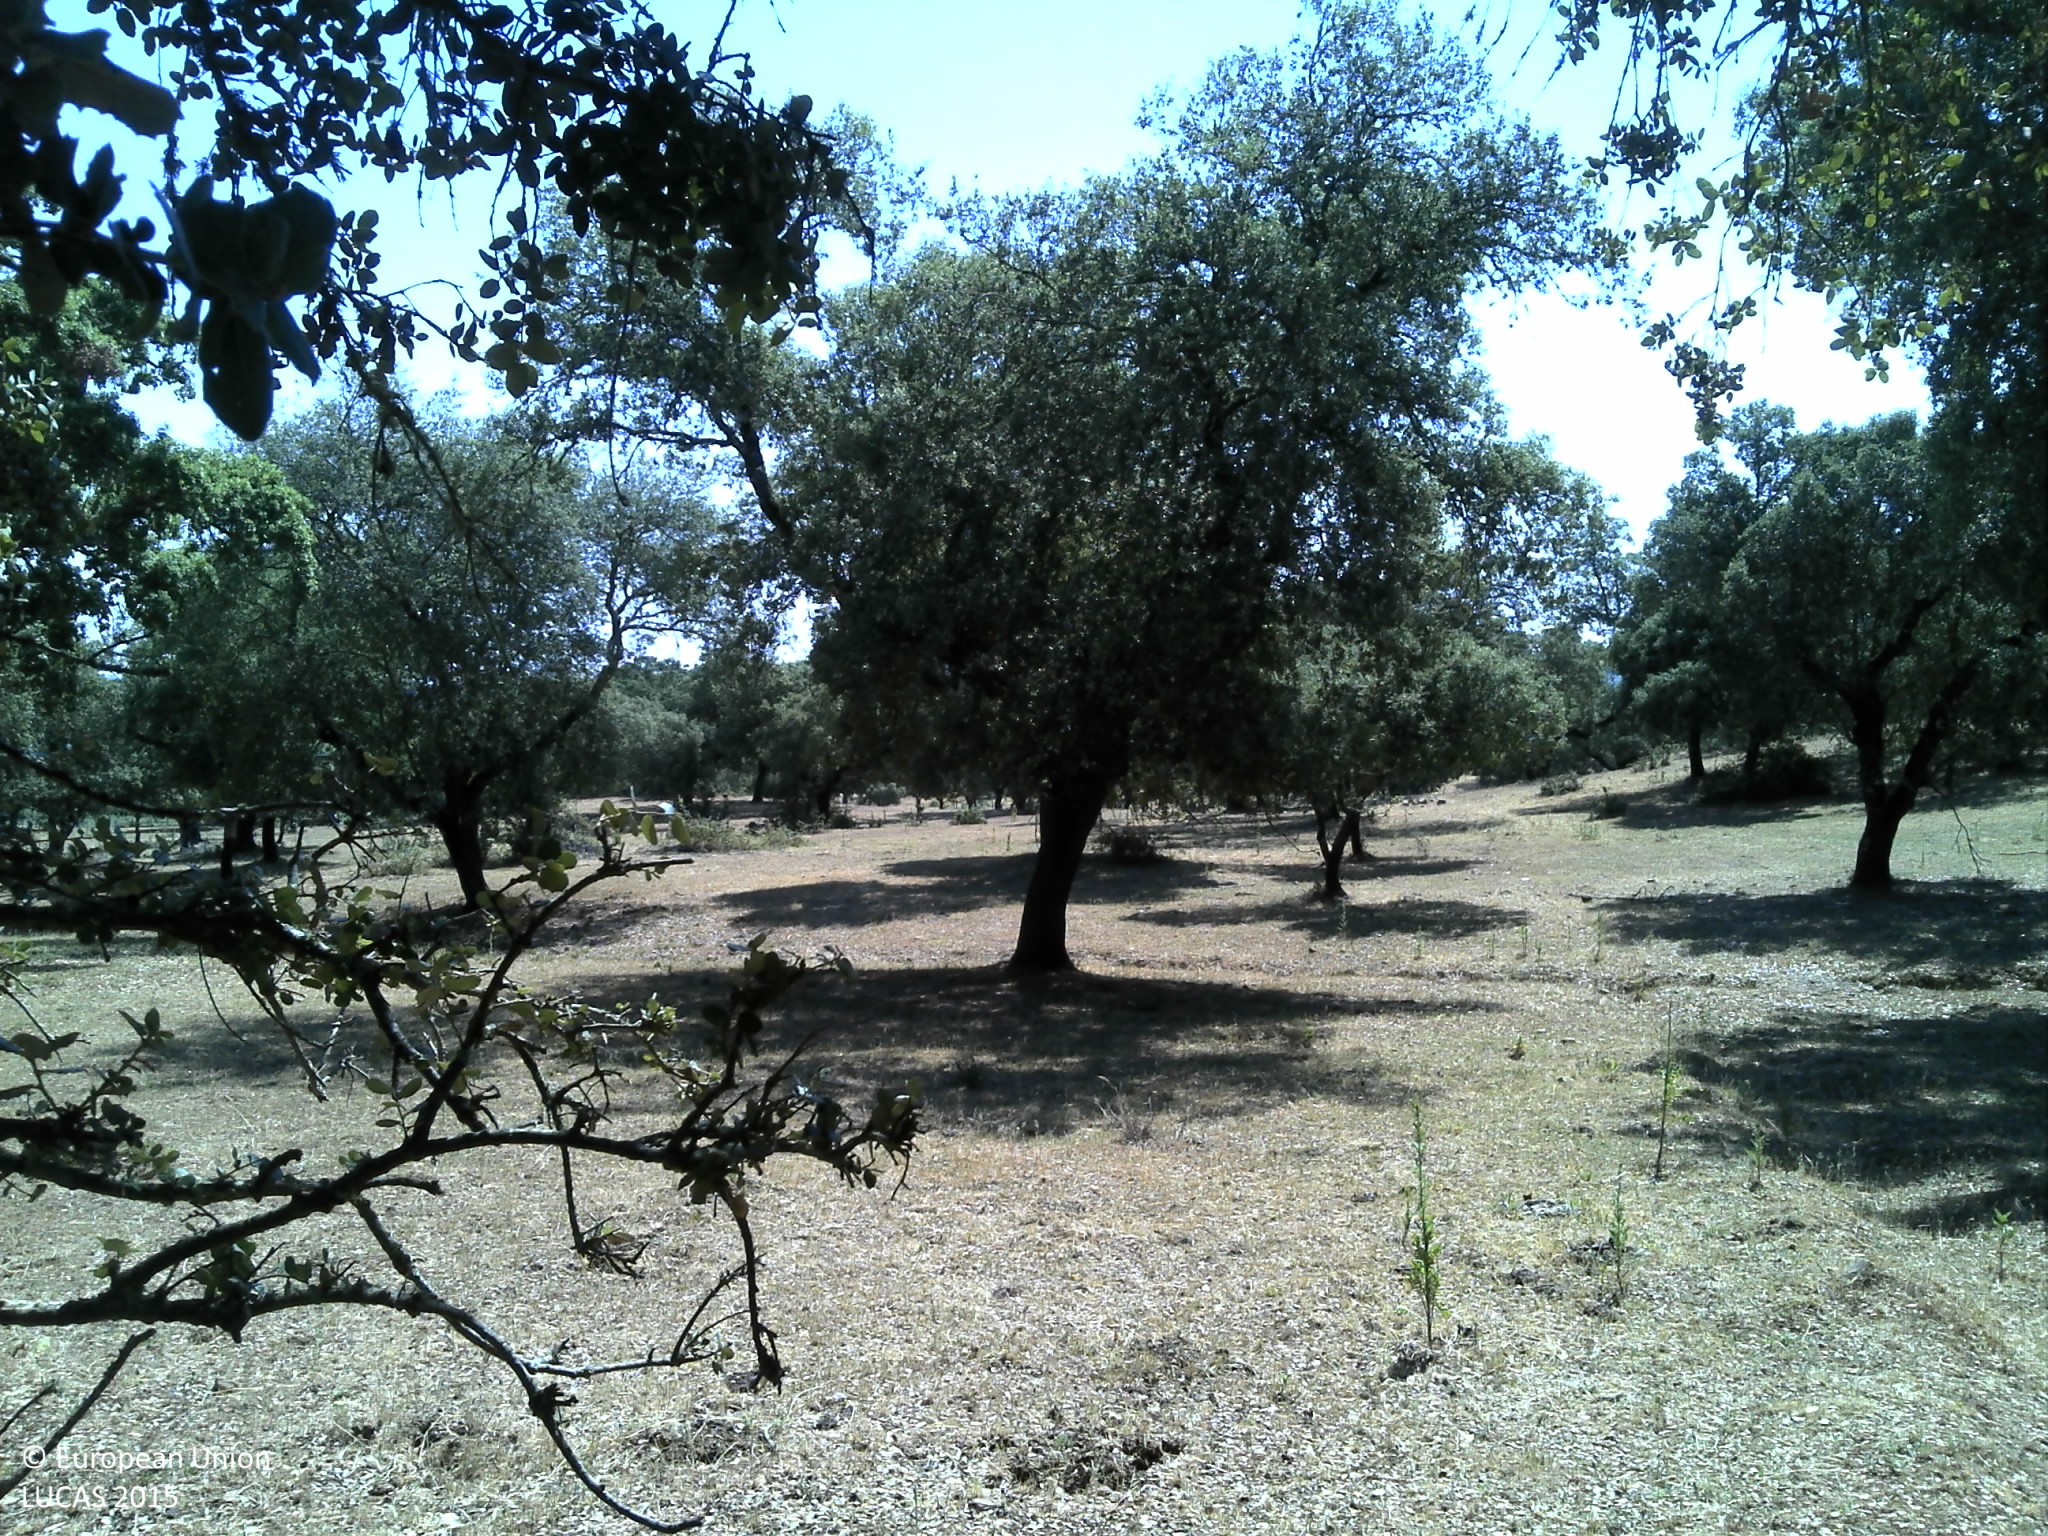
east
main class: Woodland
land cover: Broadleaved woodland
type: broadleaved evergreen forest
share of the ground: 50 - 75 %
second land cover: Grassland without tree/shrub cover
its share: 10 - 25 %
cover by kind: broadleaved forest trees 50 %, herbaceous plants 25 %, unconsolidated bare surface 25 %
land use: Forestry
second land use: Agriculture (excluding fallow land and kitchen gardens)
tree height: > 5 m
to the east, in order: Broadleaved woodland; Grassland without tree/shrub cover; Broadleaved woodland; Tracks; Broadleaved woodland; Fences; Tracks; Fences; Broadleaved woodland
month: June
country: PT
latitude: 38.6428
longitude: -8.0949
